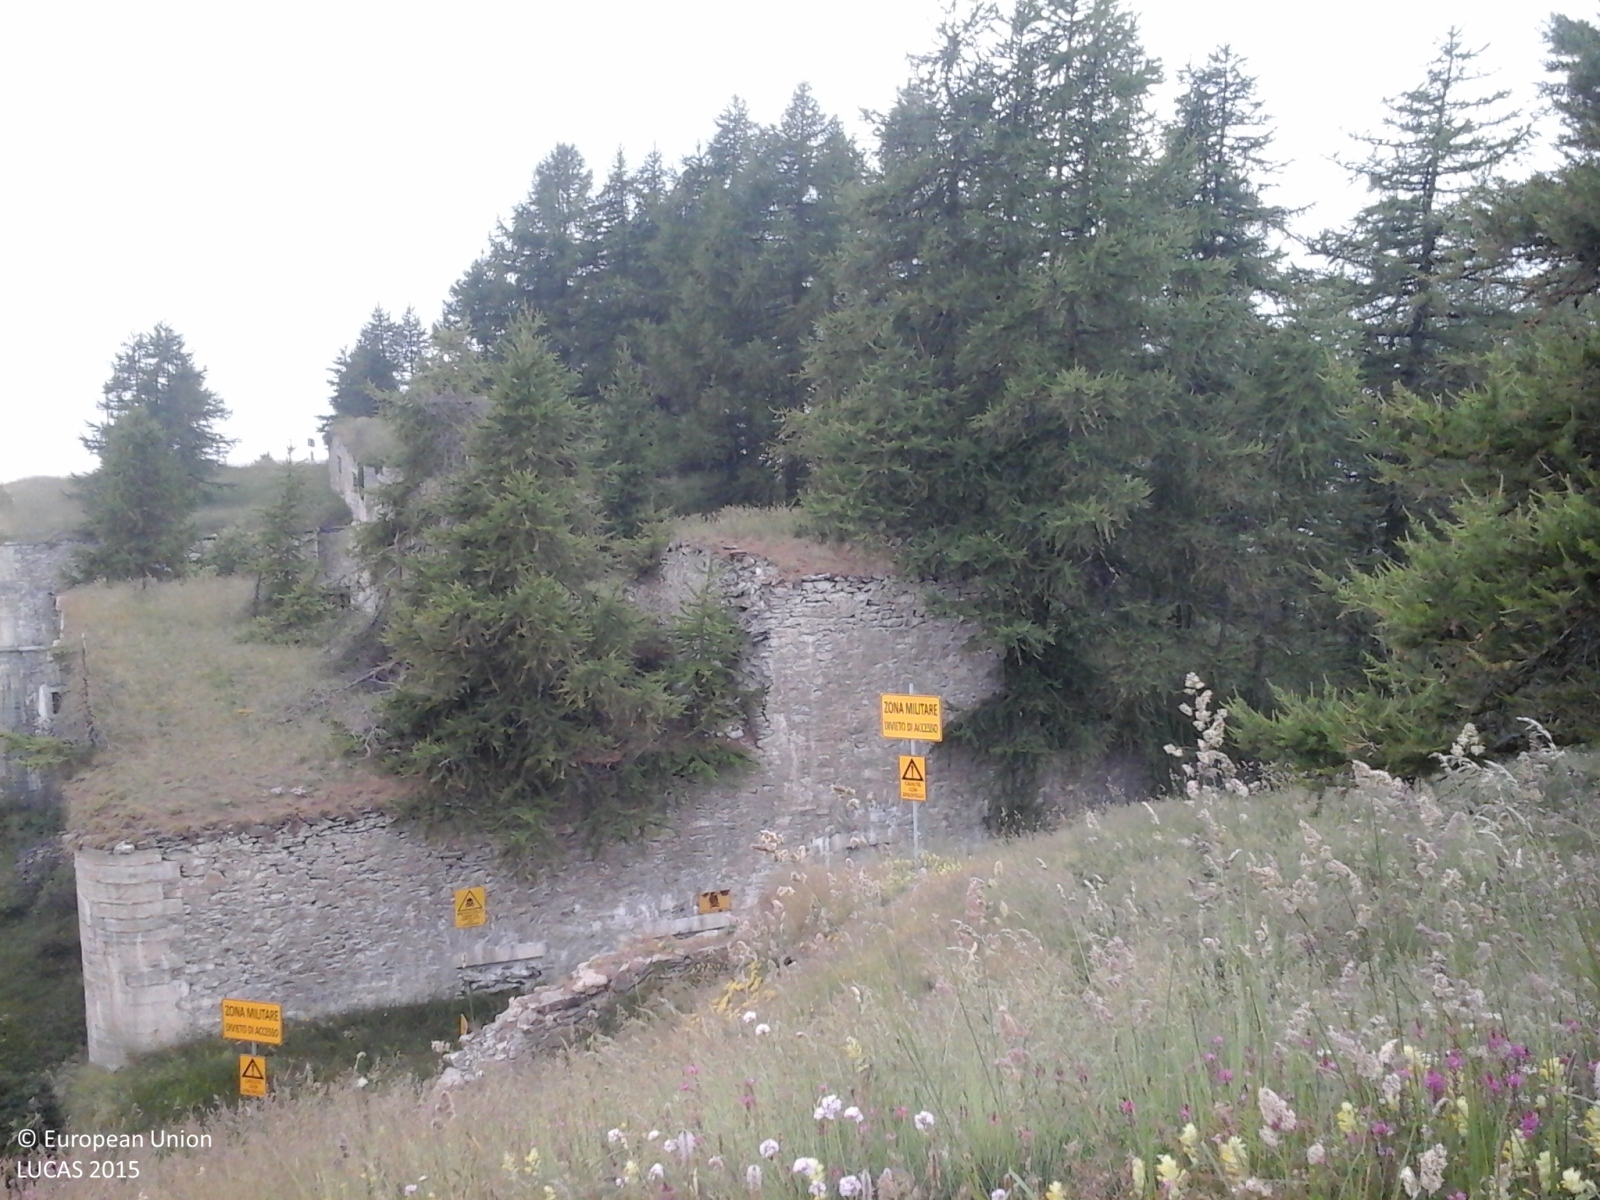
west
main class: Grassland
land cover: Grassland with sparse tree/shrub cover
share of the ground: > 75 %
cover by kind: herbaceous plants 95 %, coniferous forest trees 5 %
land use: Semi-natural and natural areas not in use
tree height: > 5 m
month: July
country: IT
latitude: 45.0483
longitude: 7.0466
